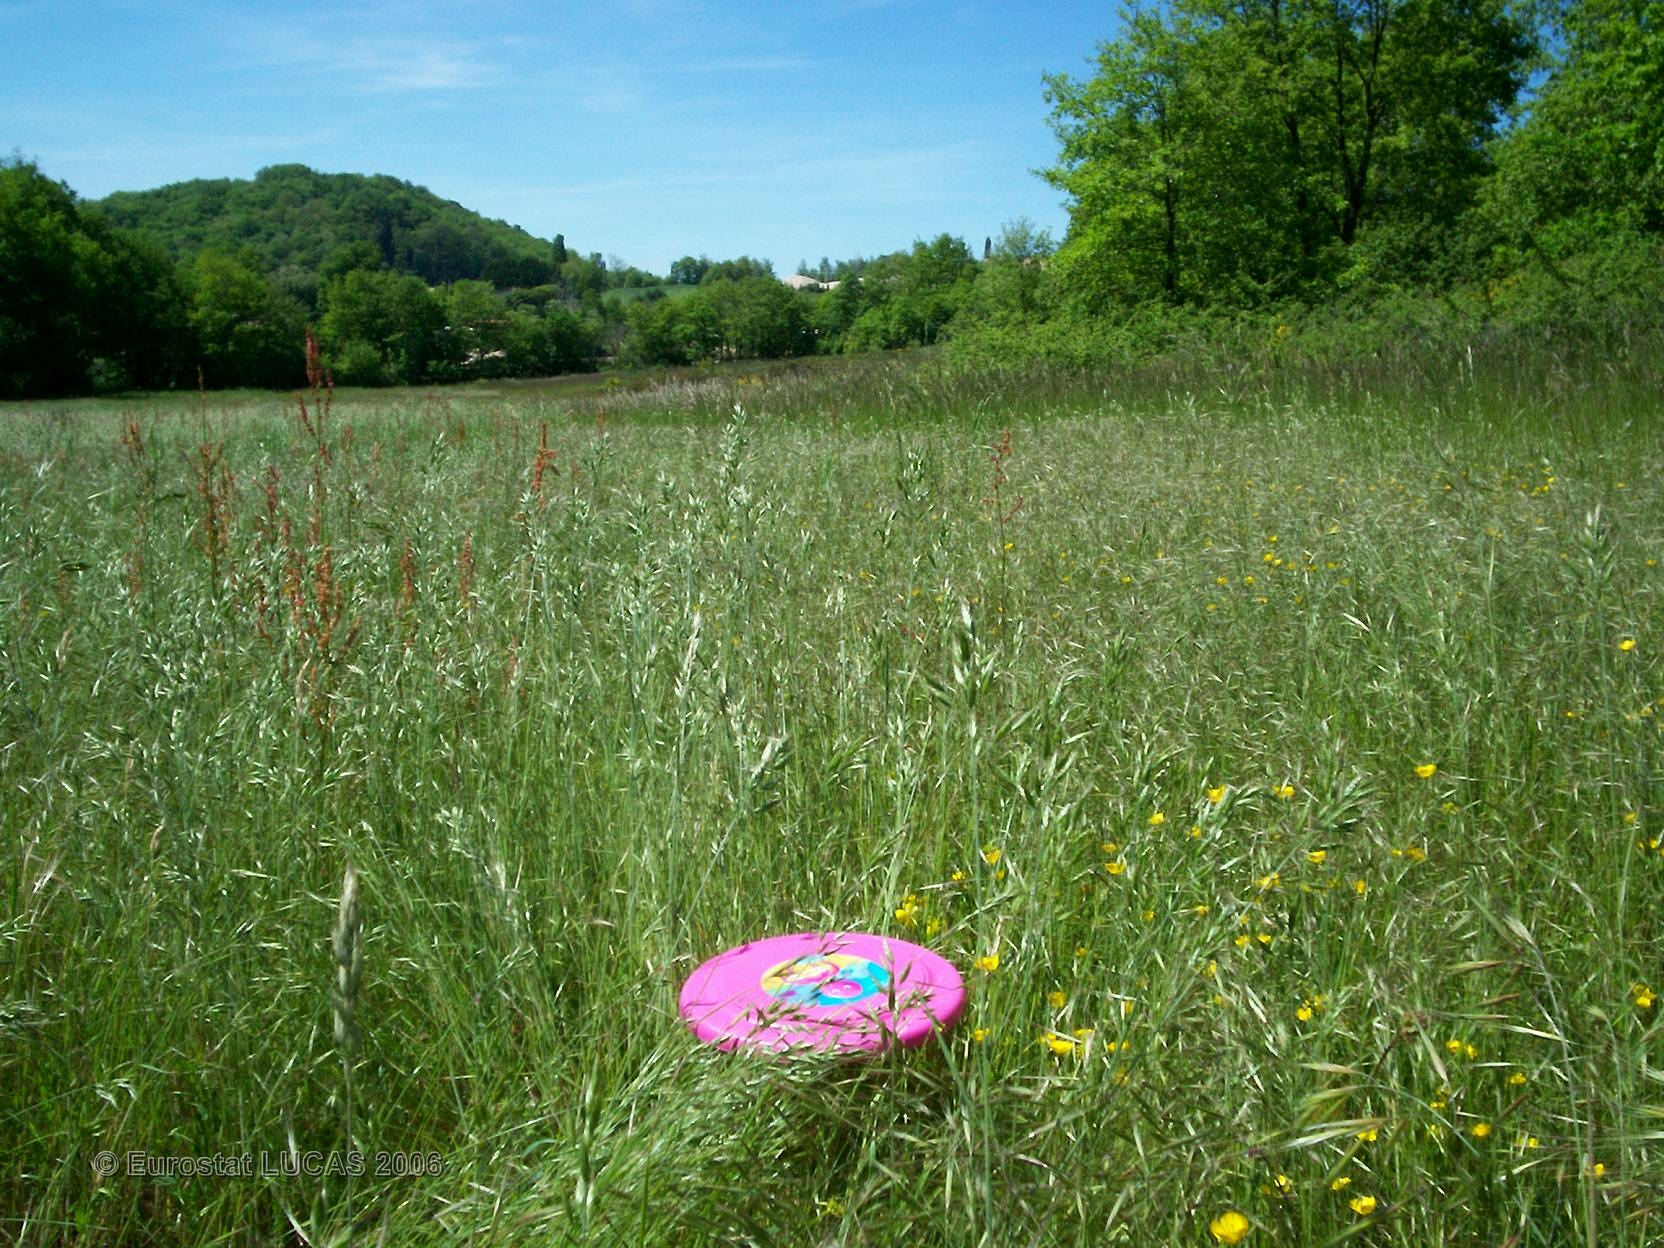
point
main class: Grassland
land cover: Grassland without tree/shrub cover
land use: Agriculture (excluding fallow land and kitchen gardens)
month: May
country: FR
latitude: 43.2066
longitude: 0.9066
